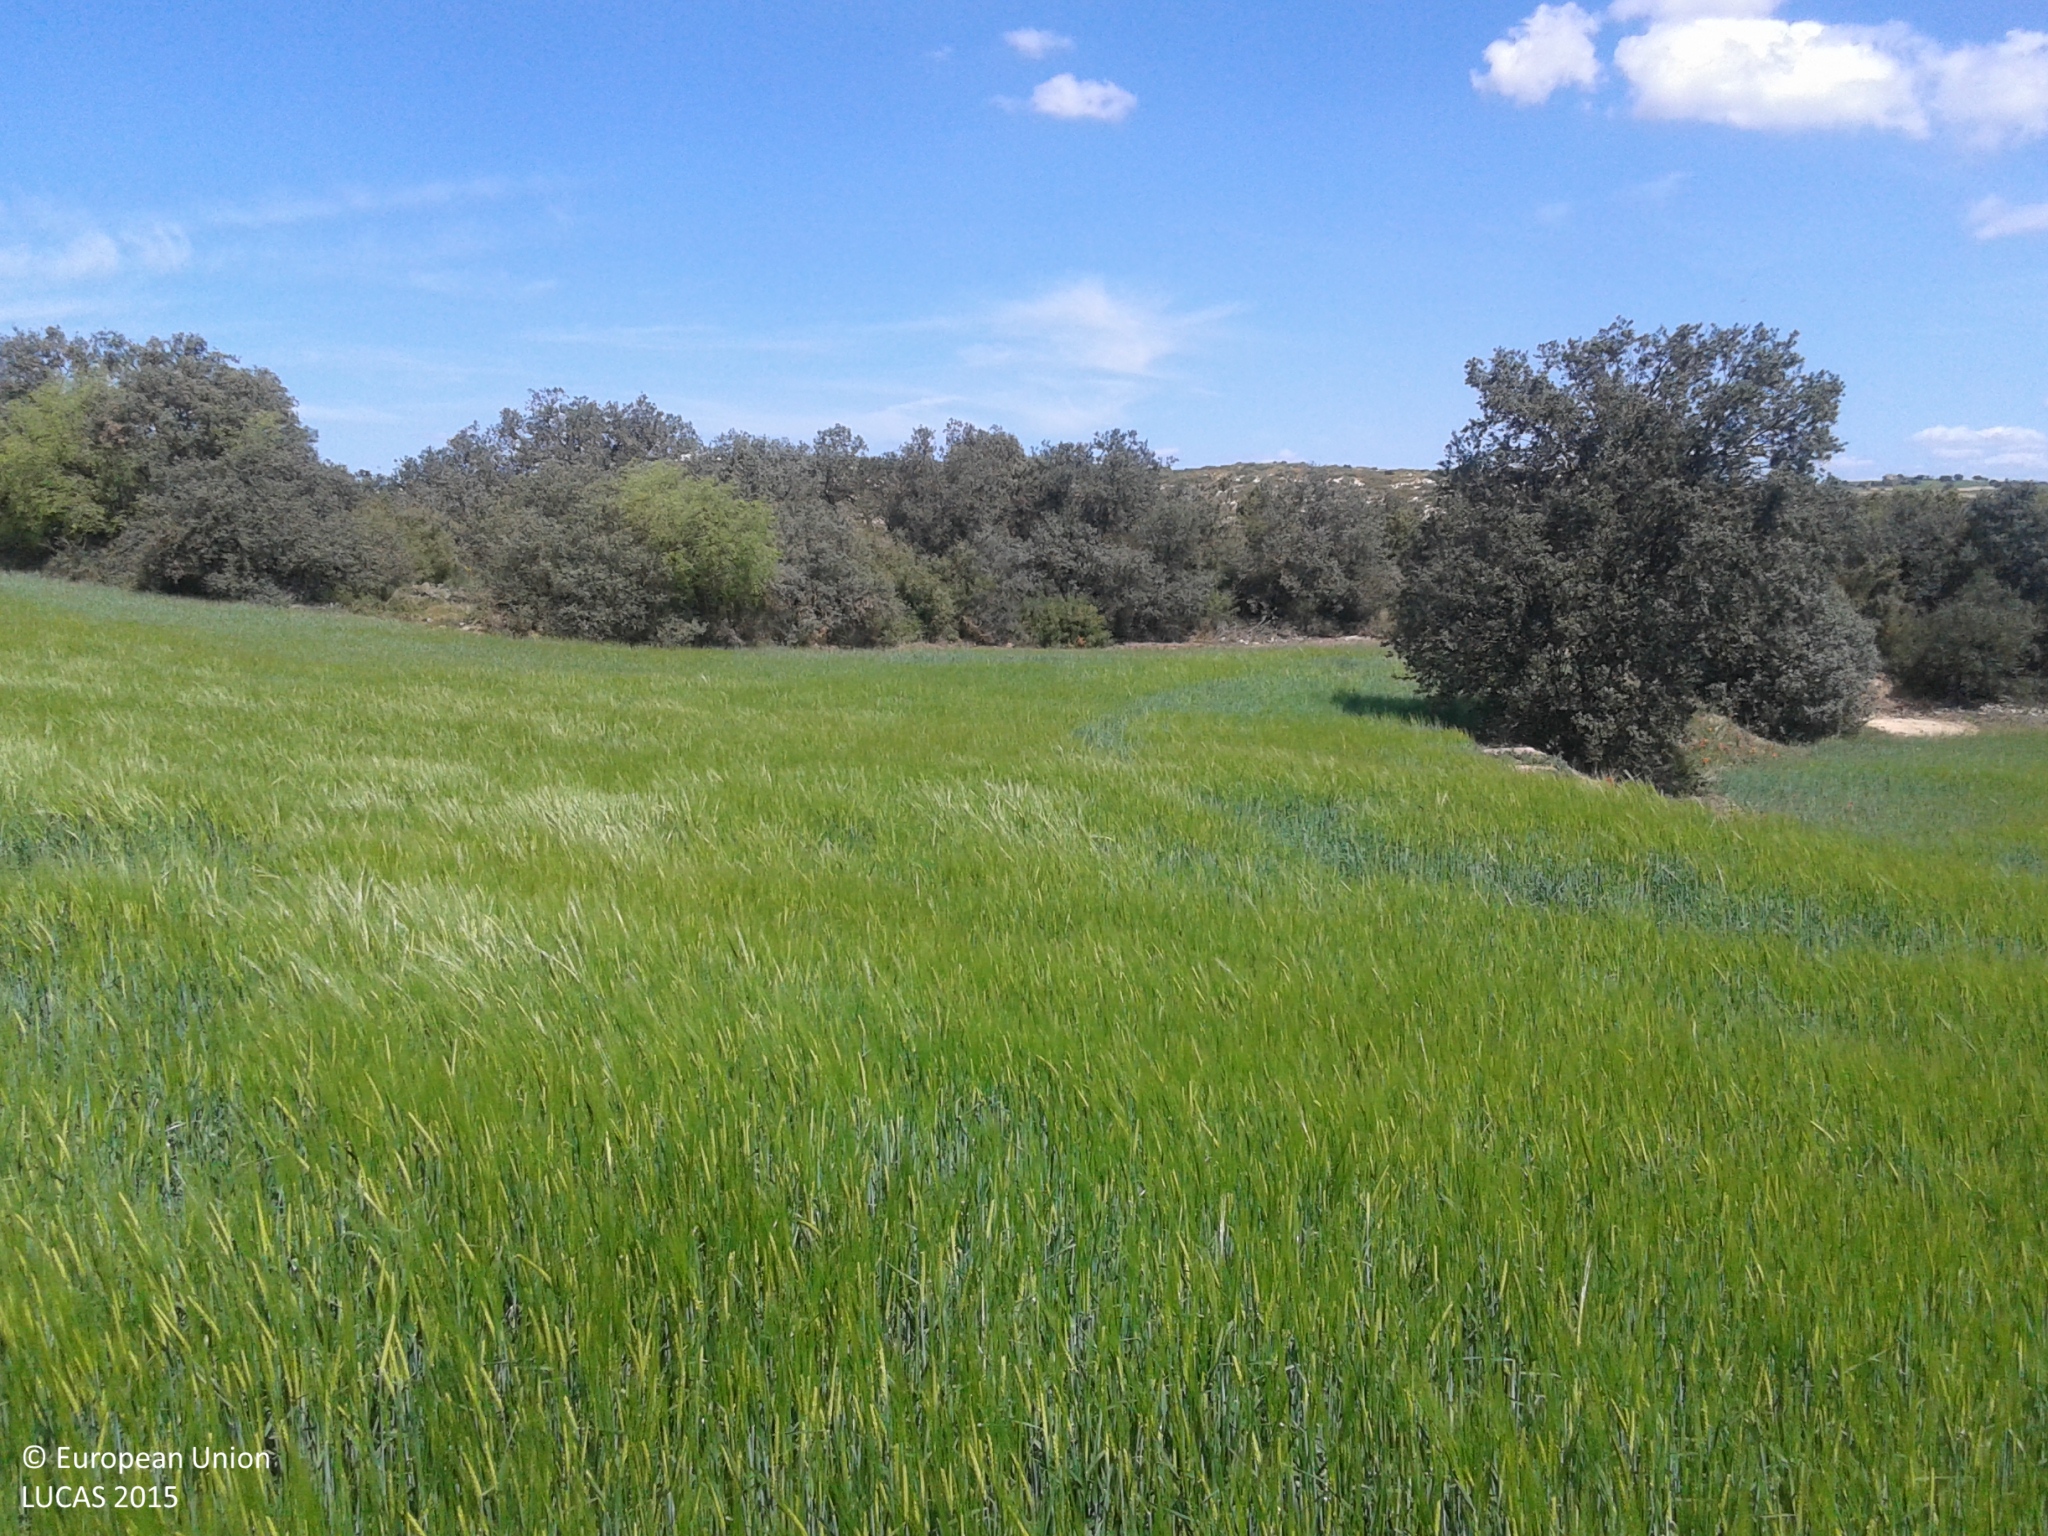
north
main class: Cropland
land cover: Barley
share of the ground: > 75 %
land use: Agriculture (excluding fallow land and kitchen gardens)
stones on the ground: 10 - 25 %
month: April
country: ES
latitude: 41.8291
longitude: 1.1384
